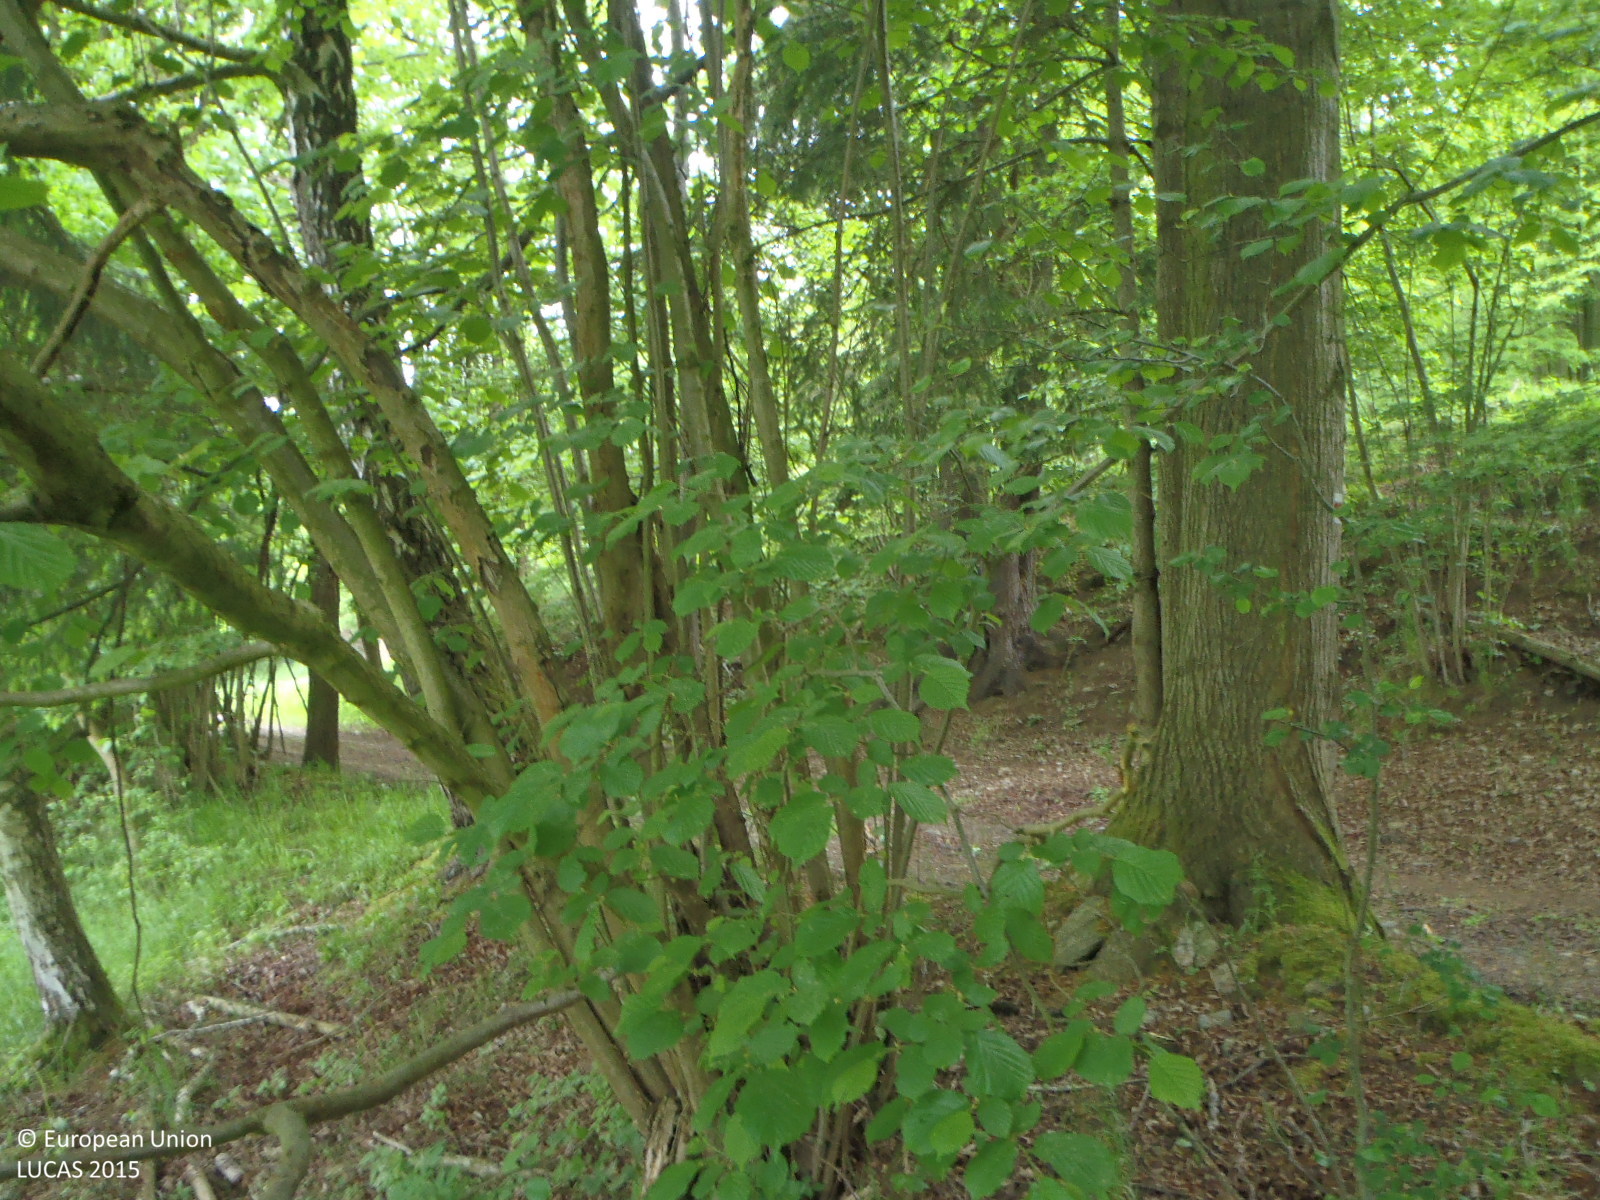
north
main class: Woodland
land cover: Broadleaved woodland
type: mesophytic deciduous forest
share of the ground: > 75 %
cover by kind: broadleaved forest trees 95 %, herbaceous plants 5 %
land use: Agriculture (excluding fallow land and kitchen gardens)
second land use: Forestry
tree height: > 5 m
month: May
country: CZ
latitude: 48.6959
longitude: 14.3618
